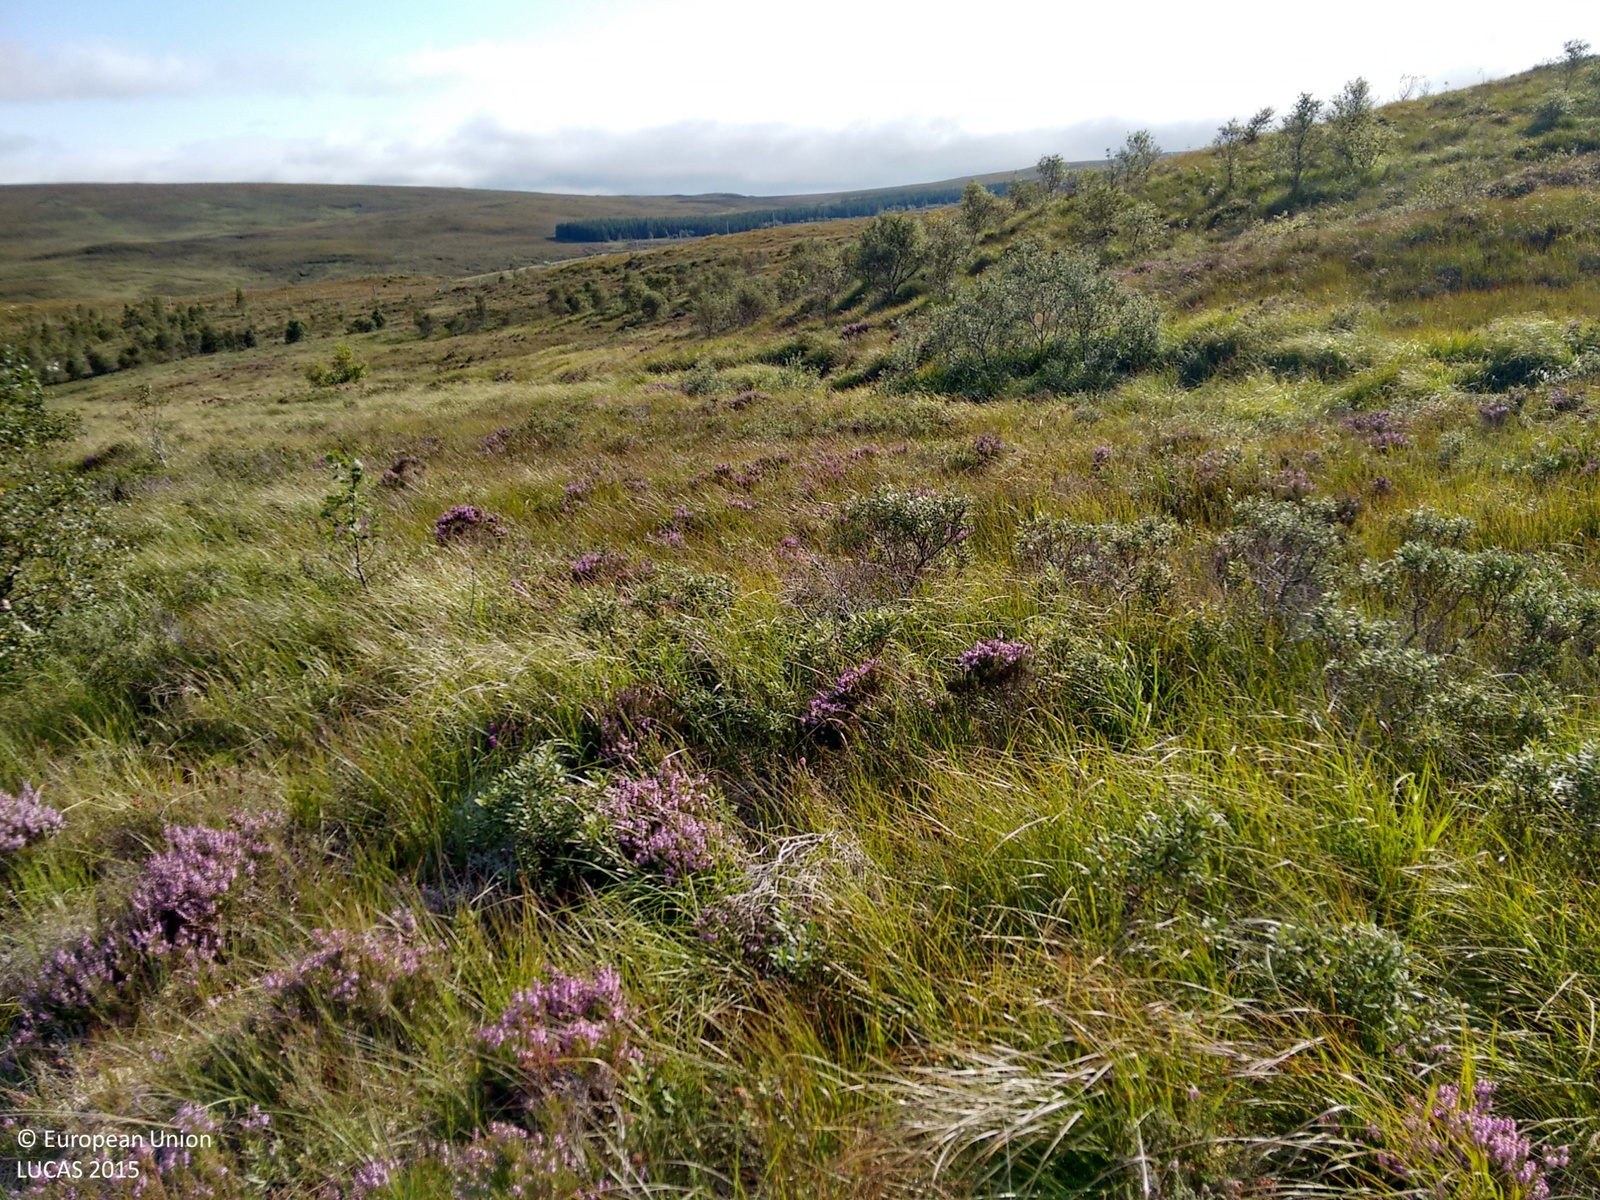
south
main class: Shrubland
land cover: Shrubland with sparse tree cover
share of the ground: > 75 %
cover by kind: shrubs 60 %, herbaceous plants 35 %, broadleaved forest trees 5 %
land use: Forestry
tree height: < 5 m
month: September
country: GB
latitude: 58.2147
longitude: -4.5040
